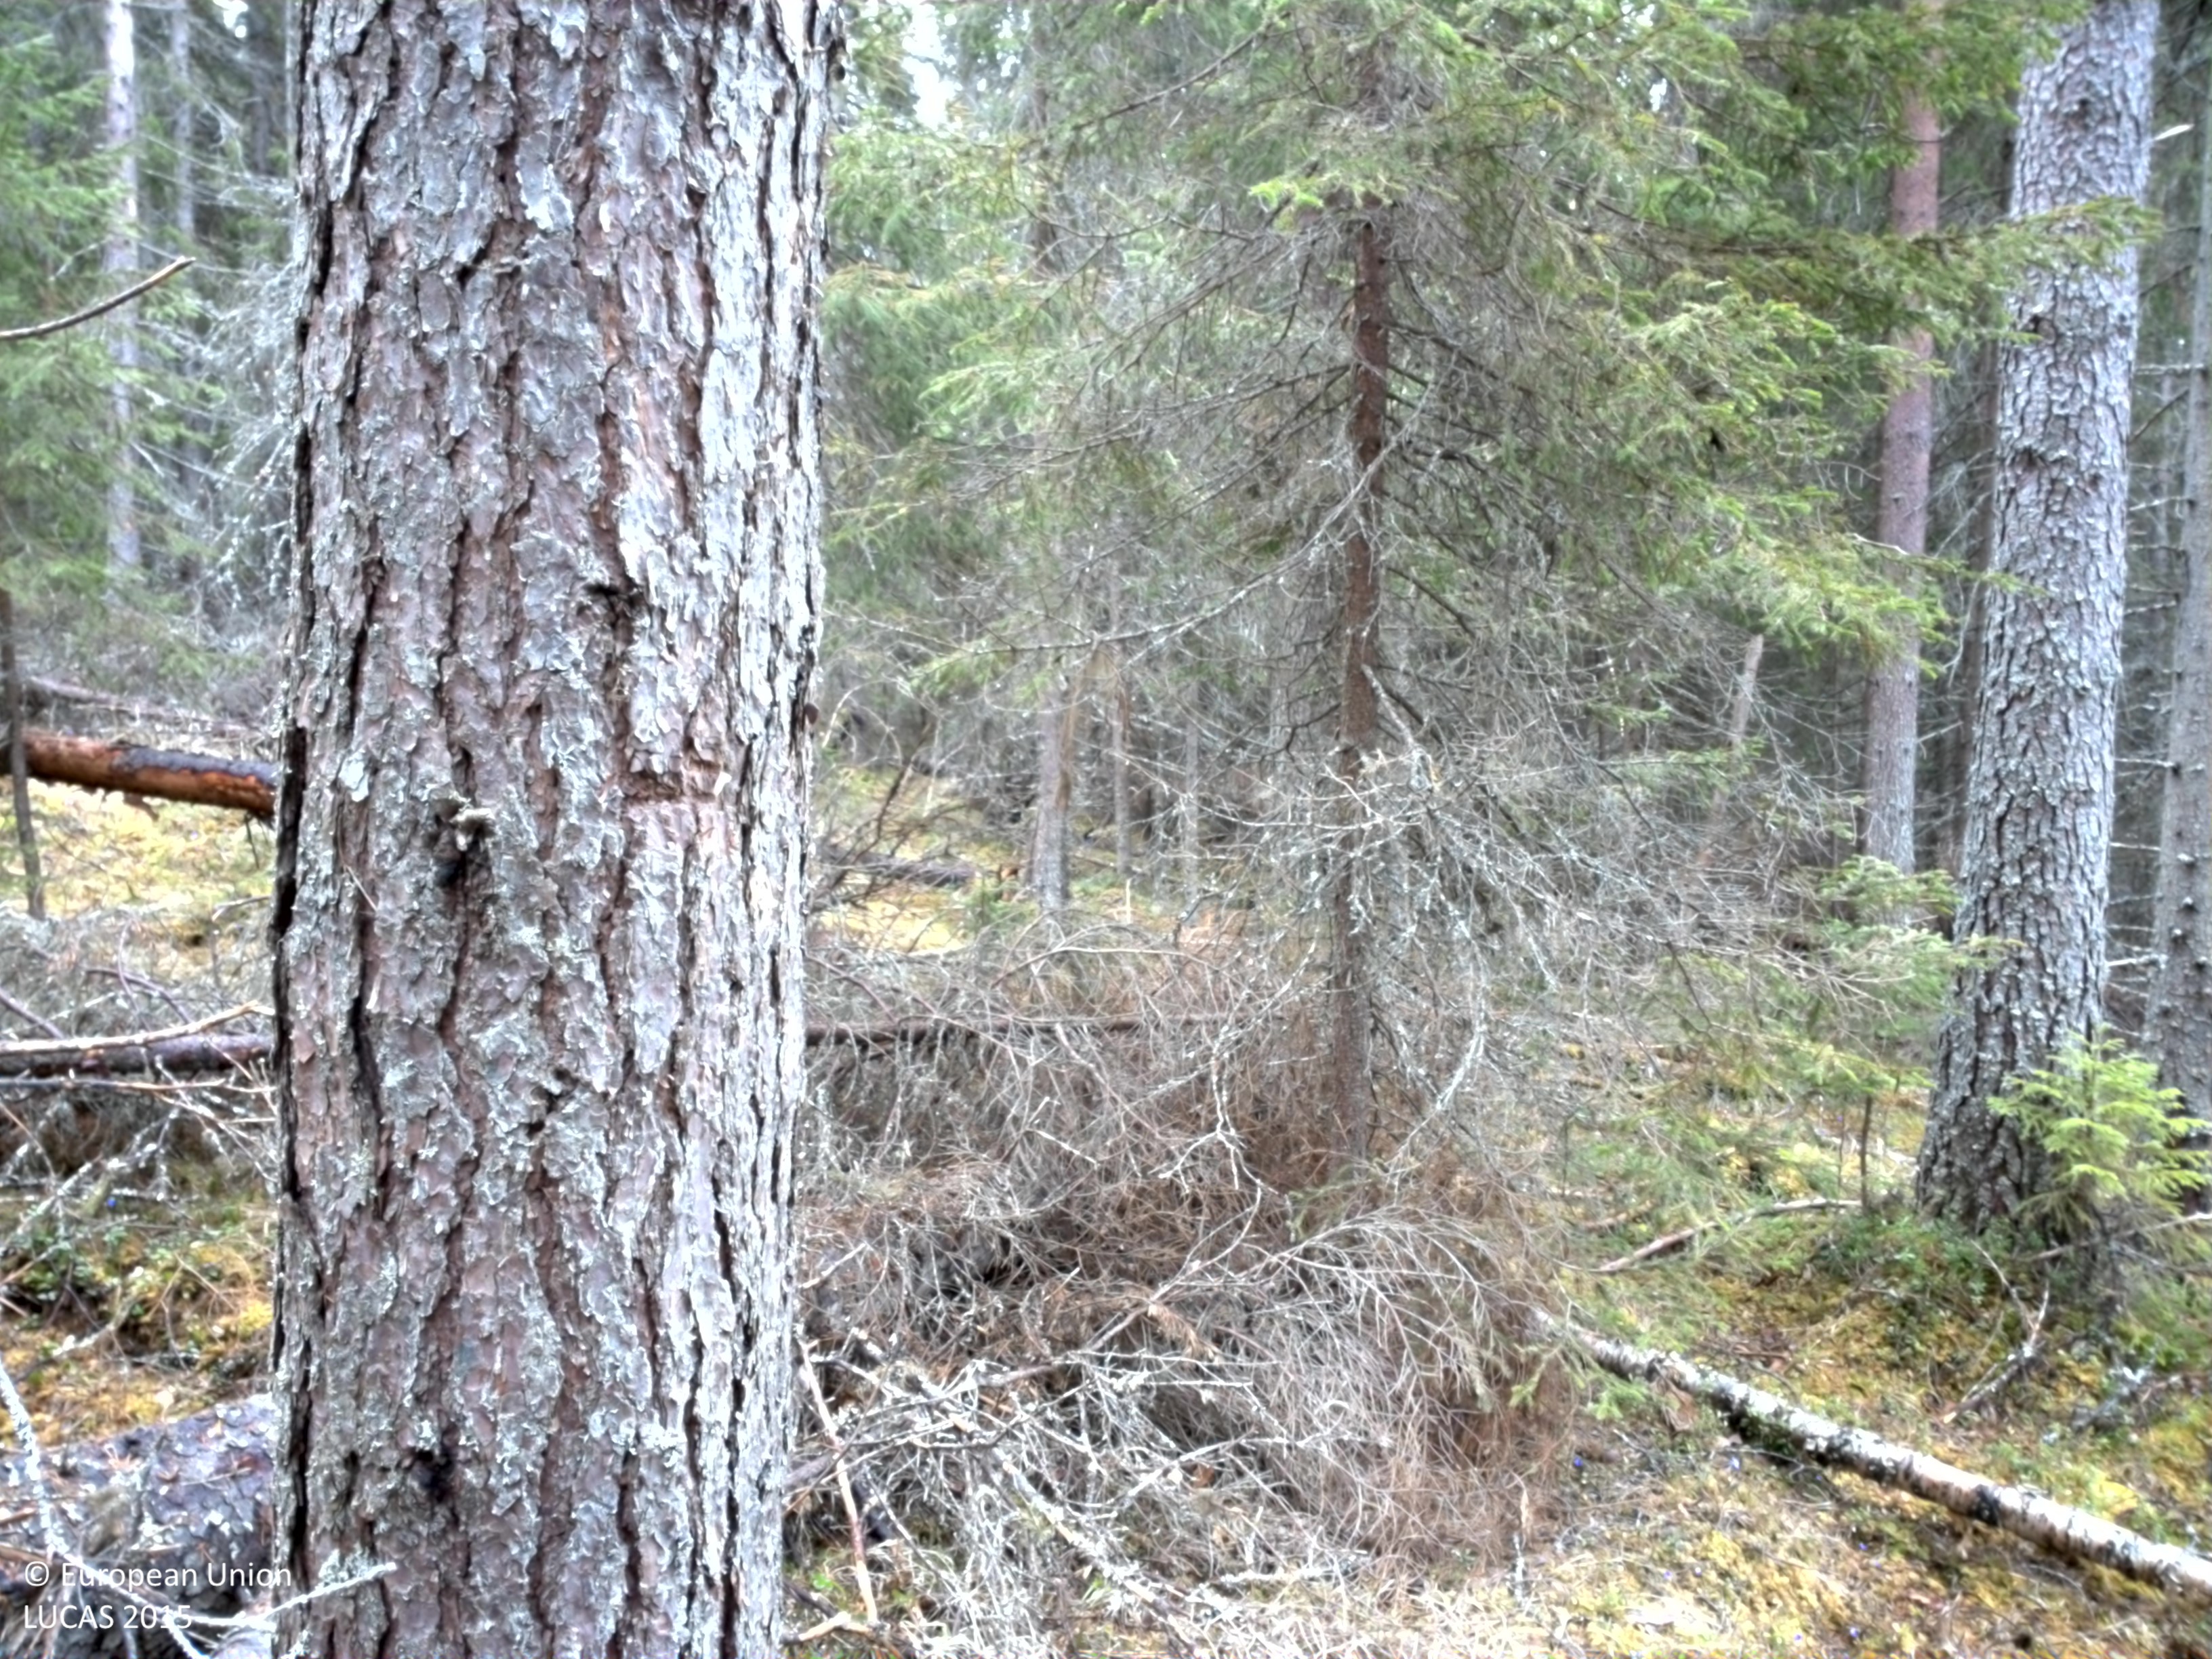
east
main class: Woodland
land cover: Spruce dominated coniferous woodland
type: boreal forest
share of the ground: > 75 %
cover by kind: coniferous forest trees 80 %, lichens and mosses 15 %, broadleaved forest trees 5 %
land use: Forestry
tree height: > 5 m
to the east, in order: Spruce dominated coniferous woodland; Ditches and canals; Spruce dominated coniferous woodland; Rivers and streams; Spruce dominated coniferous woodland; Spruce dominated mixed woodland
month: May
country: SE
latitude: 63.3758
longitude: 13.8409
